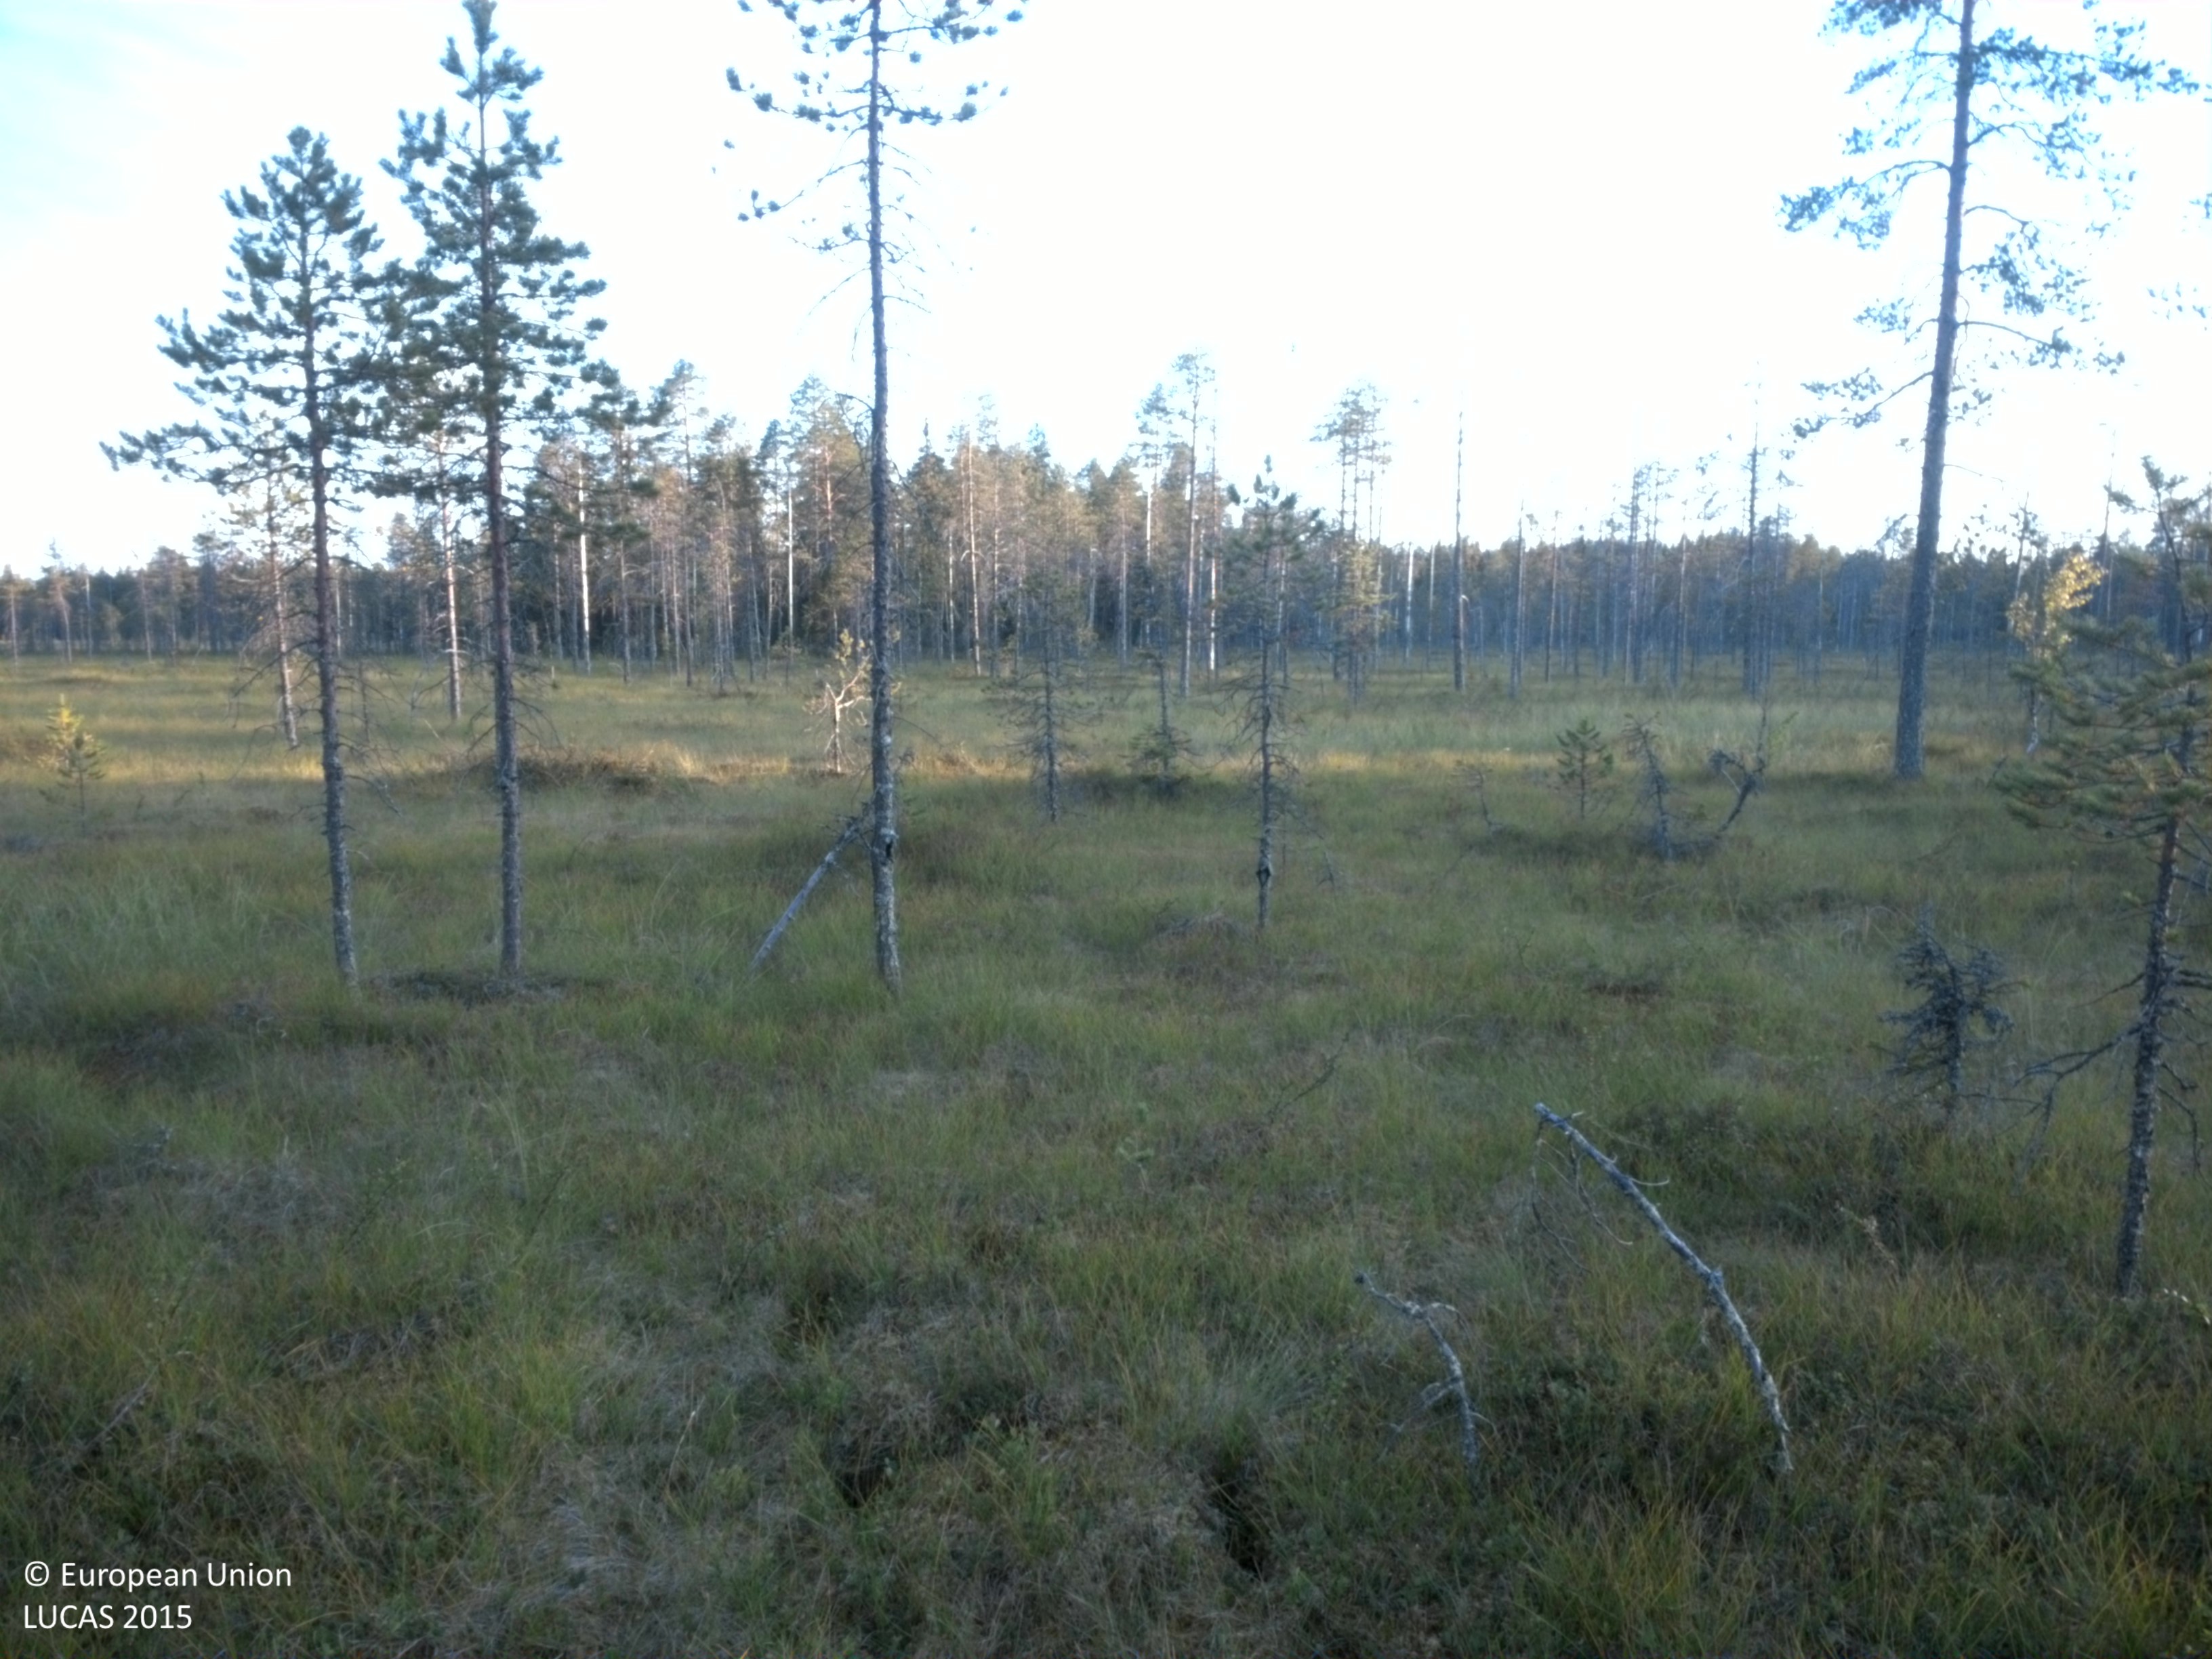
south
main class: Woodland
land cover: Pine dominated coniferous woodland
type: mire and swamp forests
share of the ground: 10 - 25 %
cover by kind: herbaceous plants 50 %, coniferous forest trees 20 %, shrubs 20 %, lichens and mosses 10 %
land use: Semi-natural and natural areas not in use
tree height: < 5 m
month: August
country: SE
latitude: 64.5298
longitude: 20.1242
